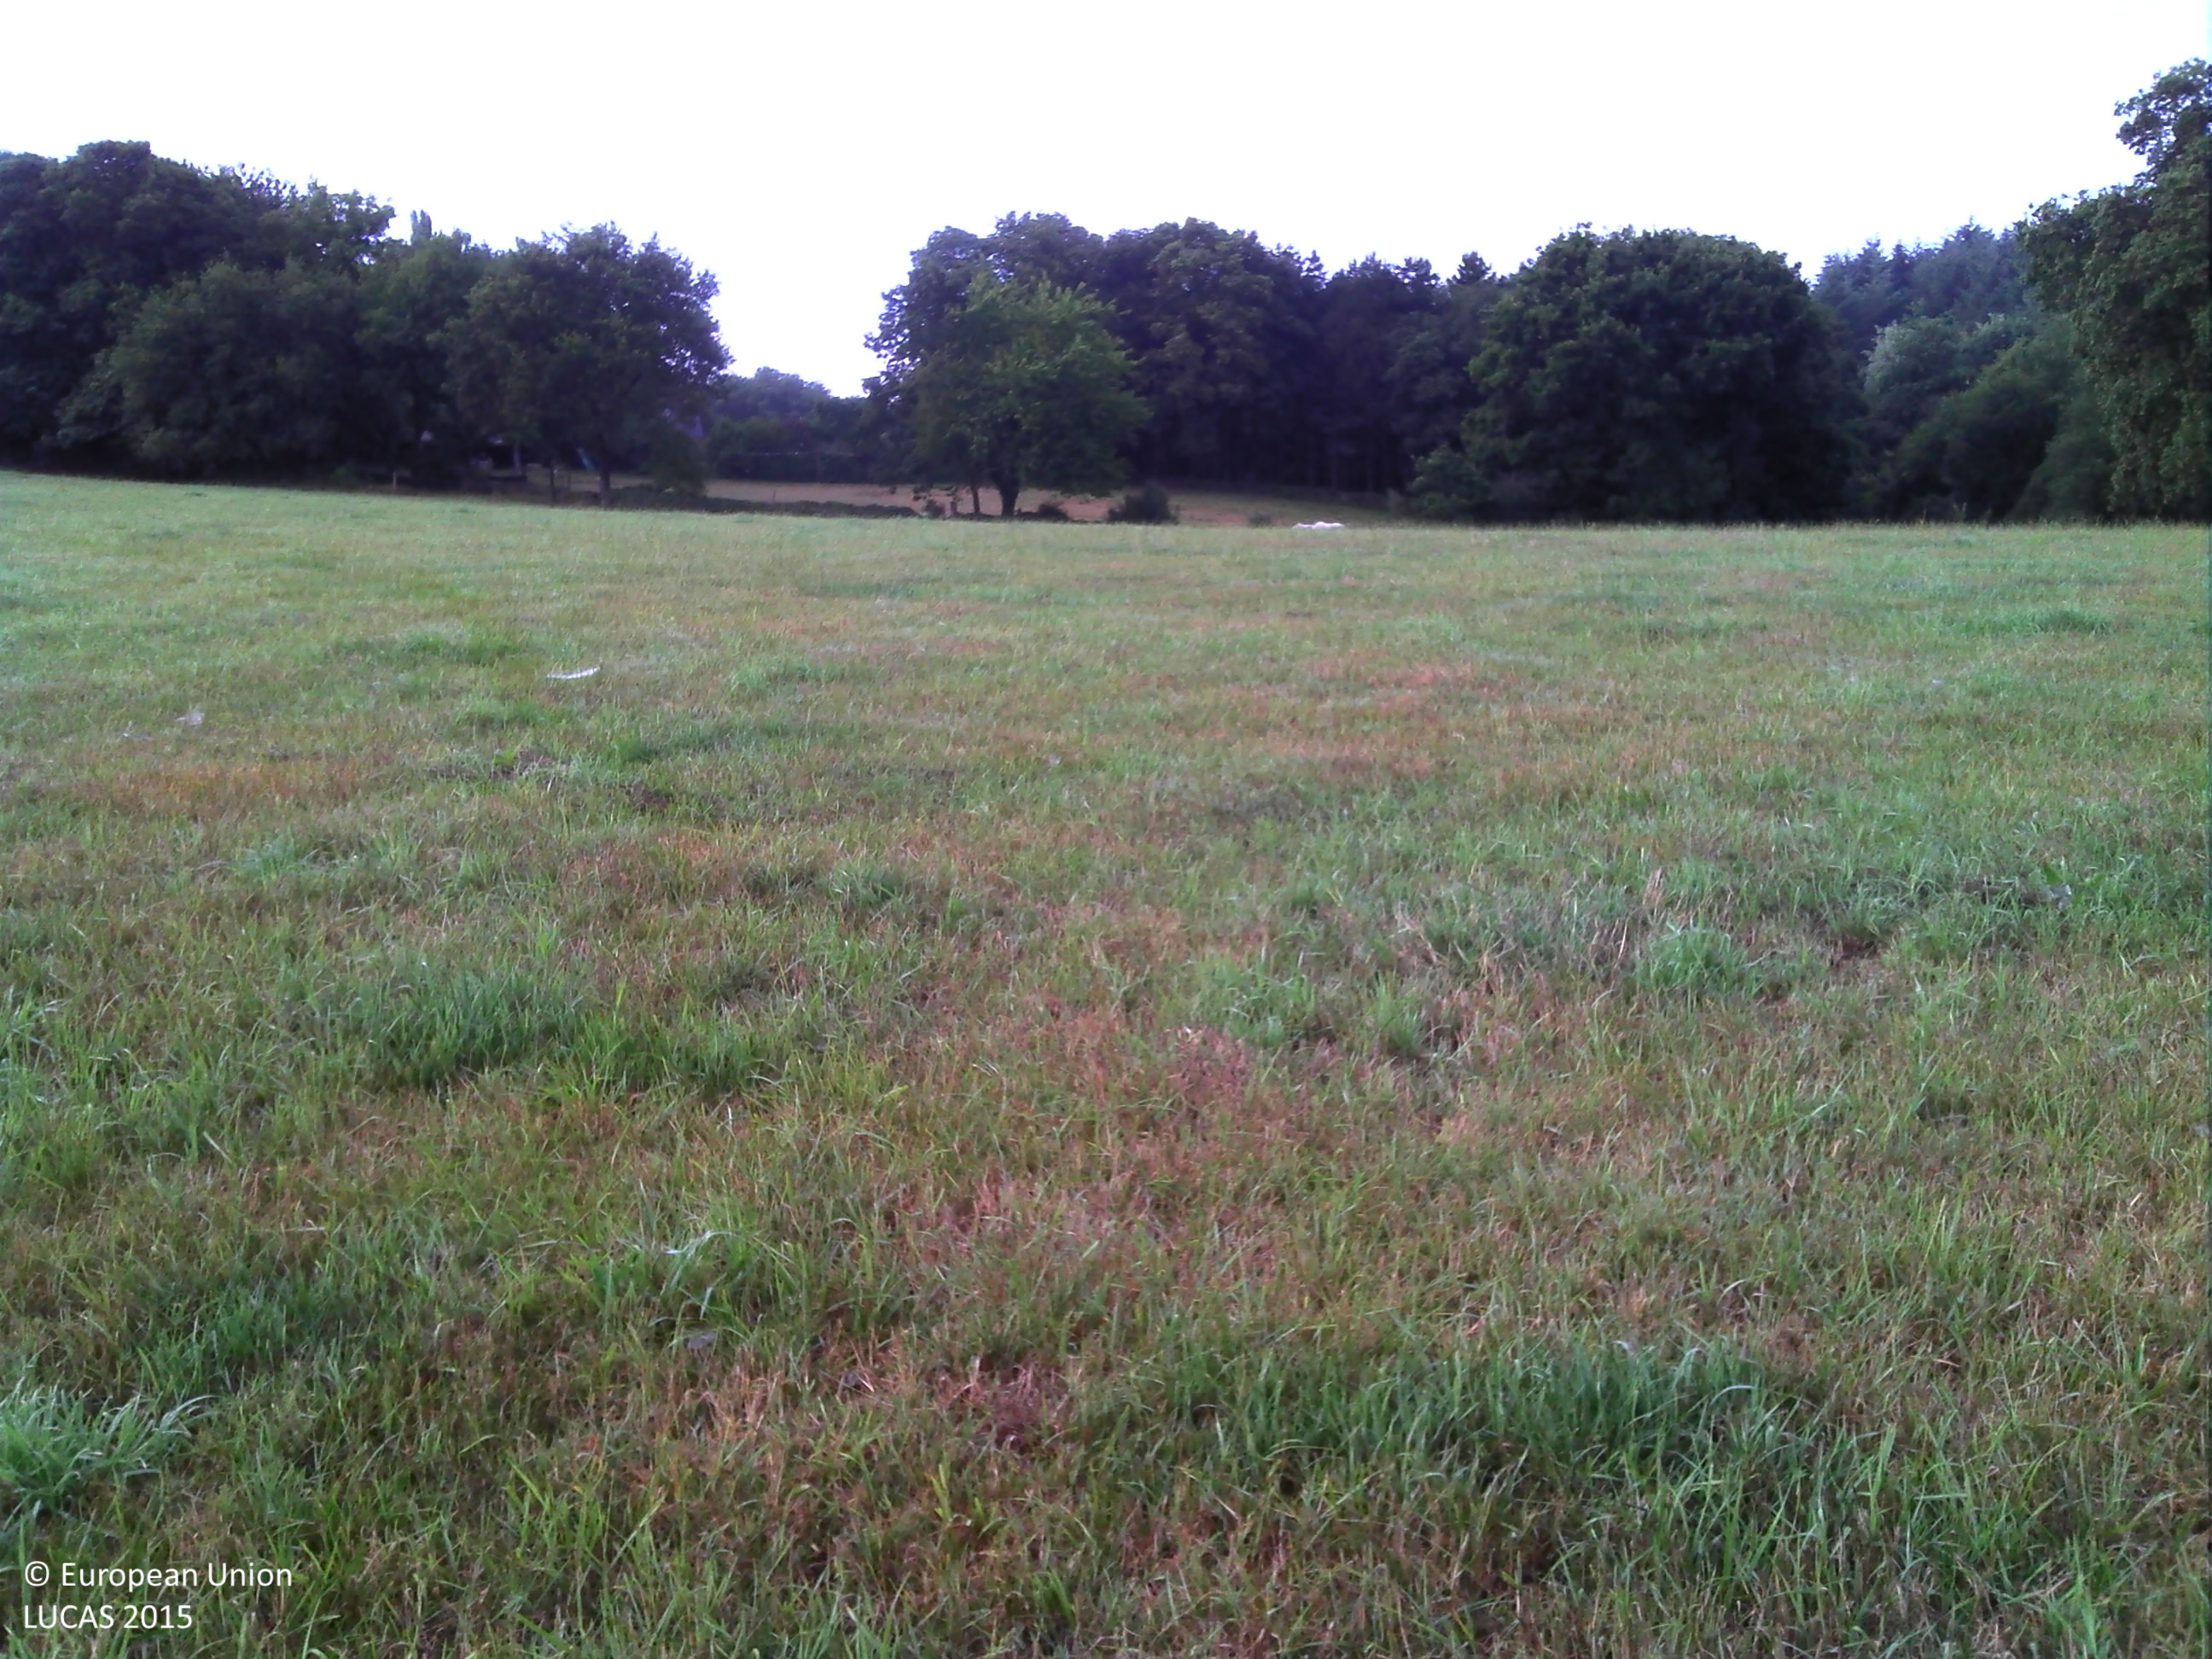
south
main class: Grassland
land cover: Grassland without tree/shrub cover
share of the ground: > 75 %
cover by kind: herbaceous plants 80 %, unconsolidated bare surface 20 %
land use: Agriculture (excluding fallow land and kitchen gardens)
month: July
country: FR
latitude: 47.7427
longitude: -2.9894
